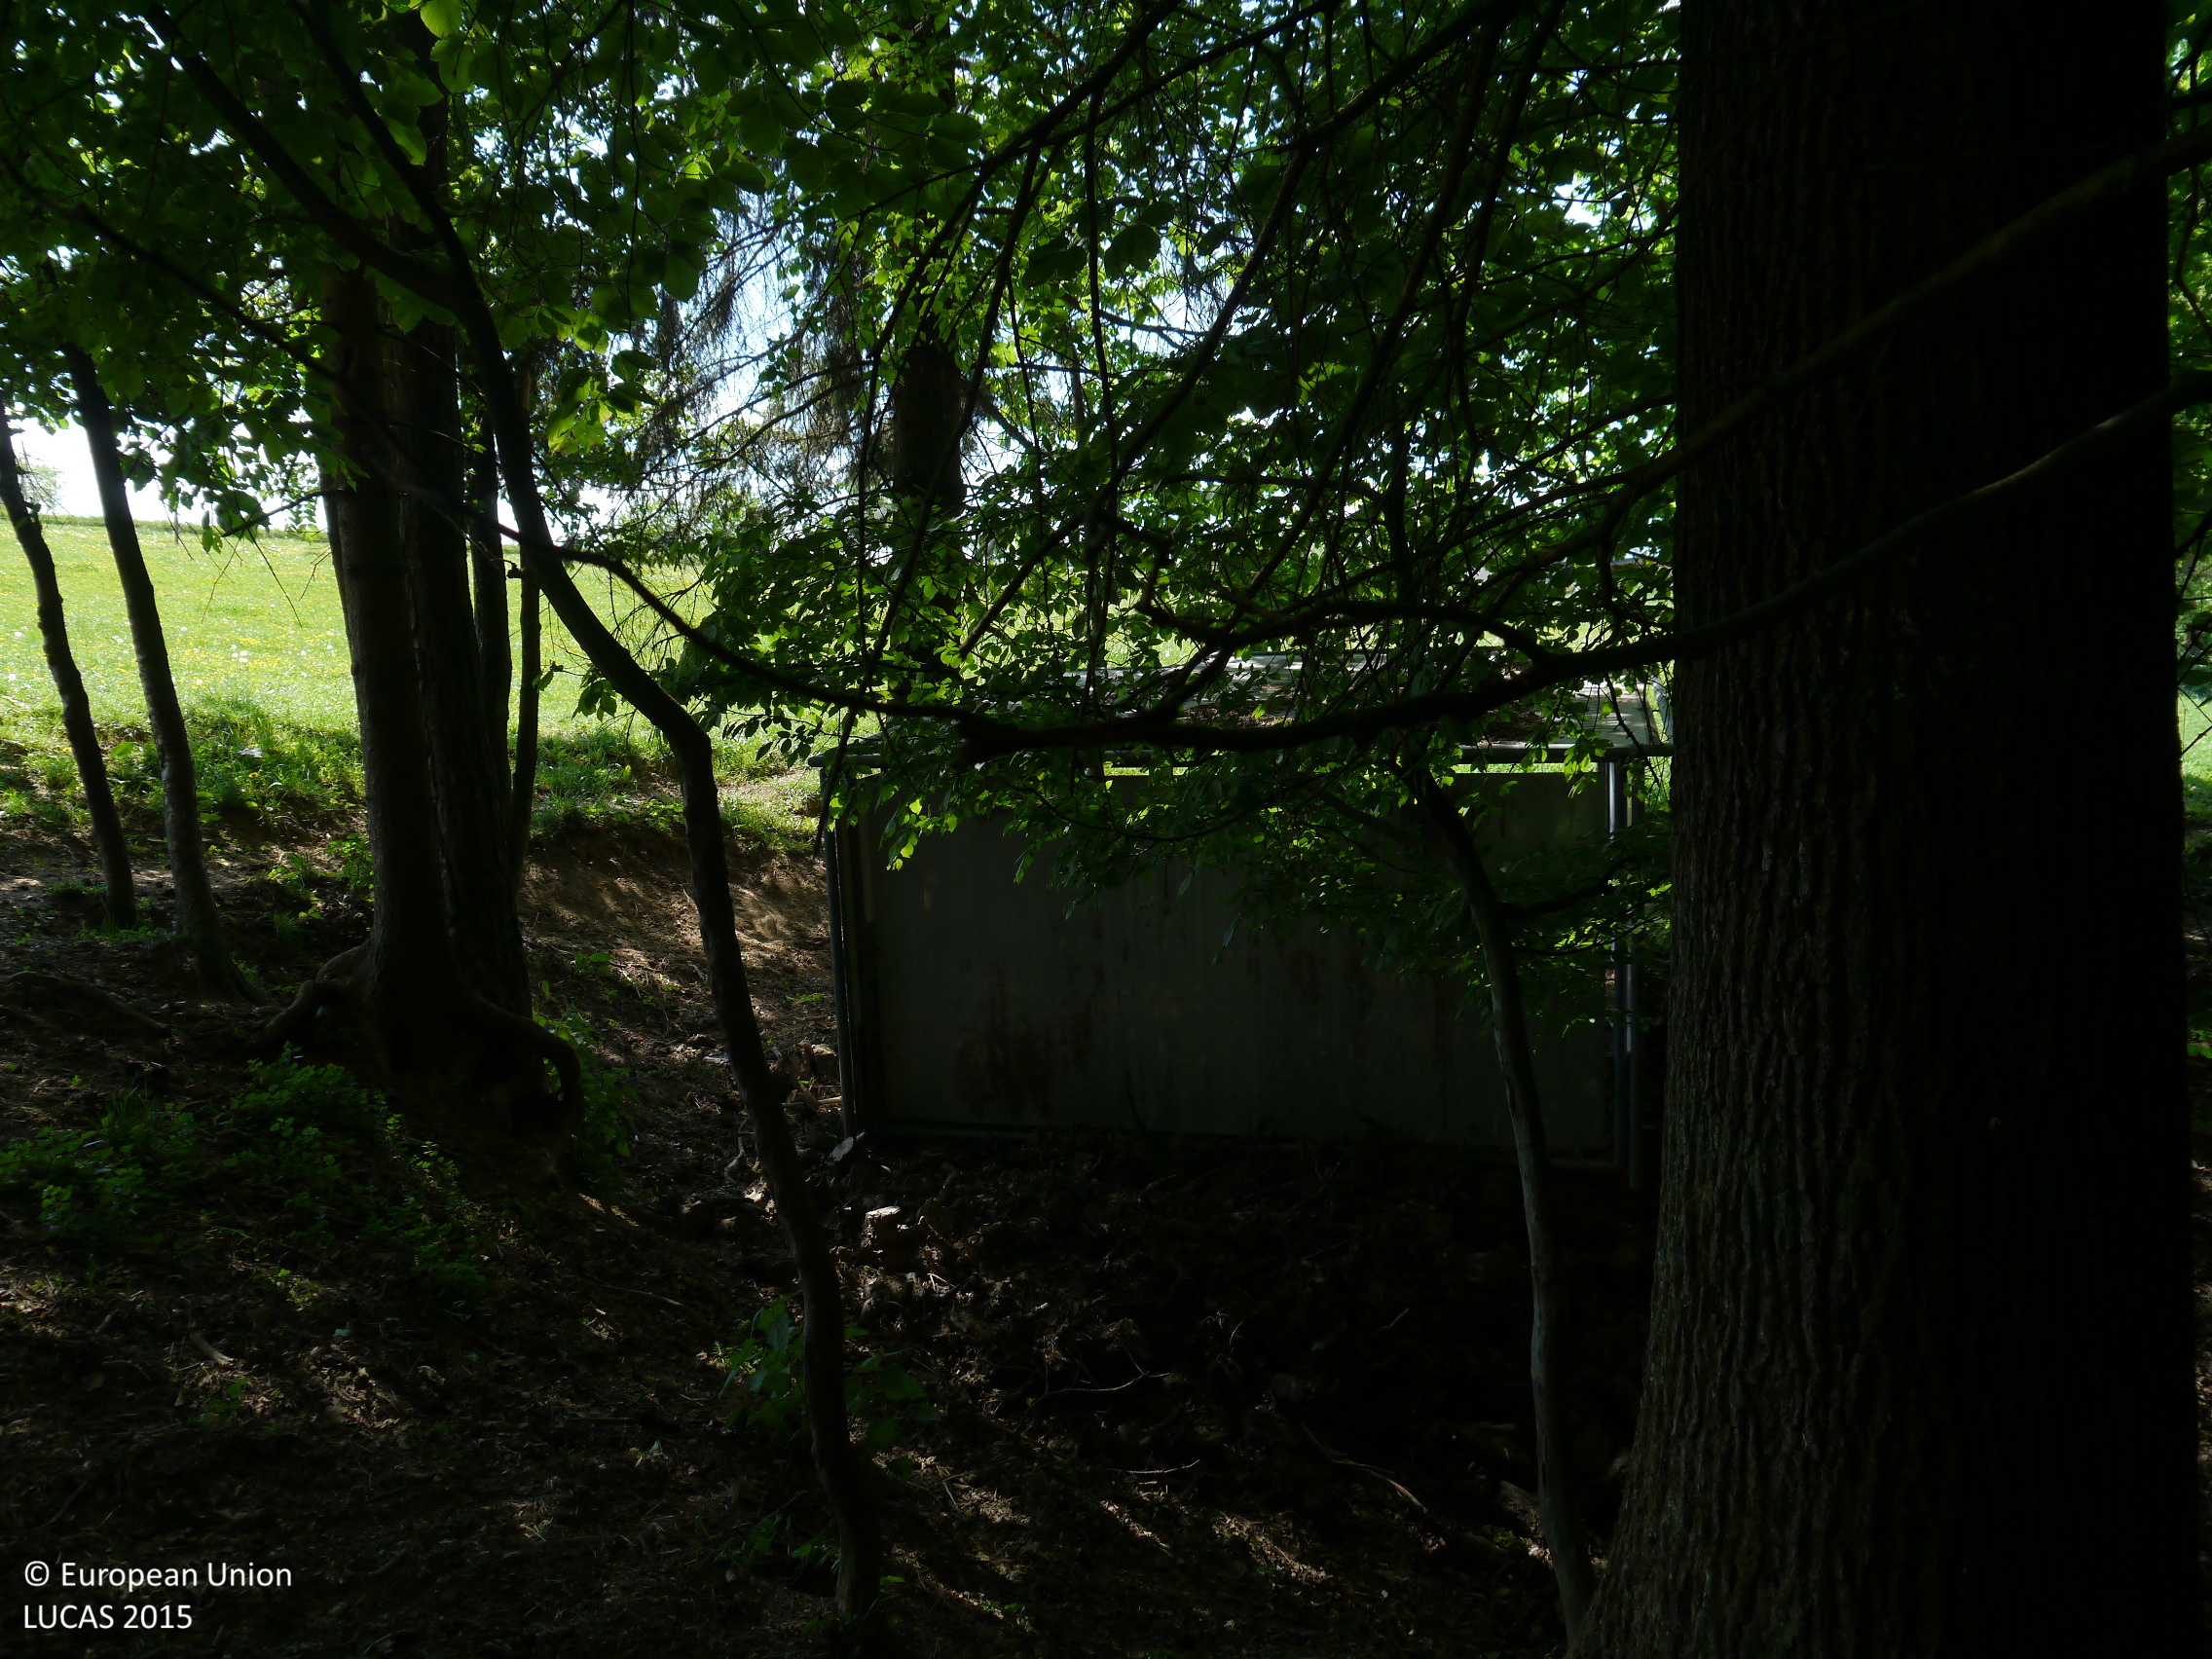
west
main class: Woodland
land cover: Spruce dominated mixed woodland
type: hemiboreal forest and nemoral coniferous forest and mixed broadleaved-coniferous forest
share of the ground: > 75 %
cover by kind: coniferous forest trees 50 %, broadleaved forest trees 45 %, unconsolidated bare surface 5 %
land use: Forestry
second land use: Agriculture (excluding fallow land and kitchen gardens)
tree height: > 5 m
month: May
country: AT
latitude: 47.0484
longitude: 15.3306
